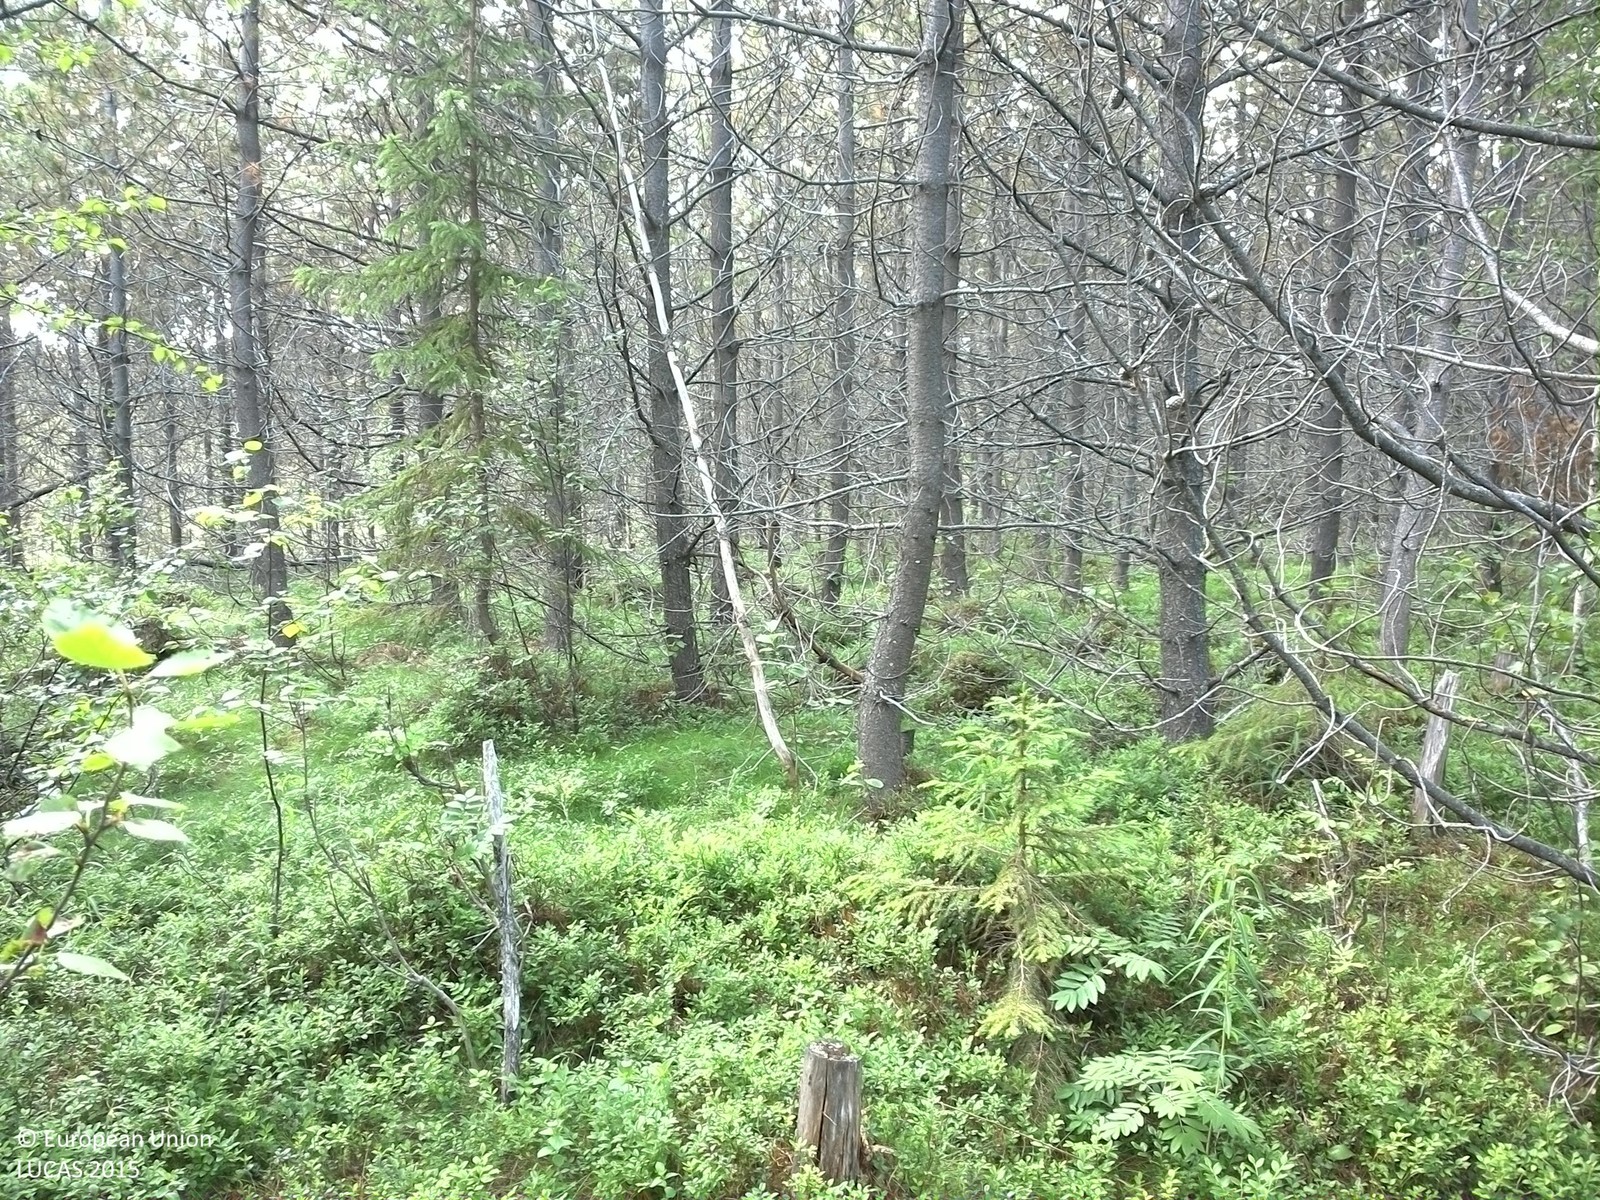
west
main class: Woodland
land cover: Pine dominated coniferous woodland
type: exotic forest
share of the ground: 50 - 75 %
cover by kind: coniferous forest trees 55 %, shrubs 15 %, broadleaved forest trees 10 %, herbaceous plants 10 %, lichens and mosses 10 %
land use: Forestry
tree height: > 5 m
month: July
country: SE
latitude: 64.6131
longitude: 15.4259
